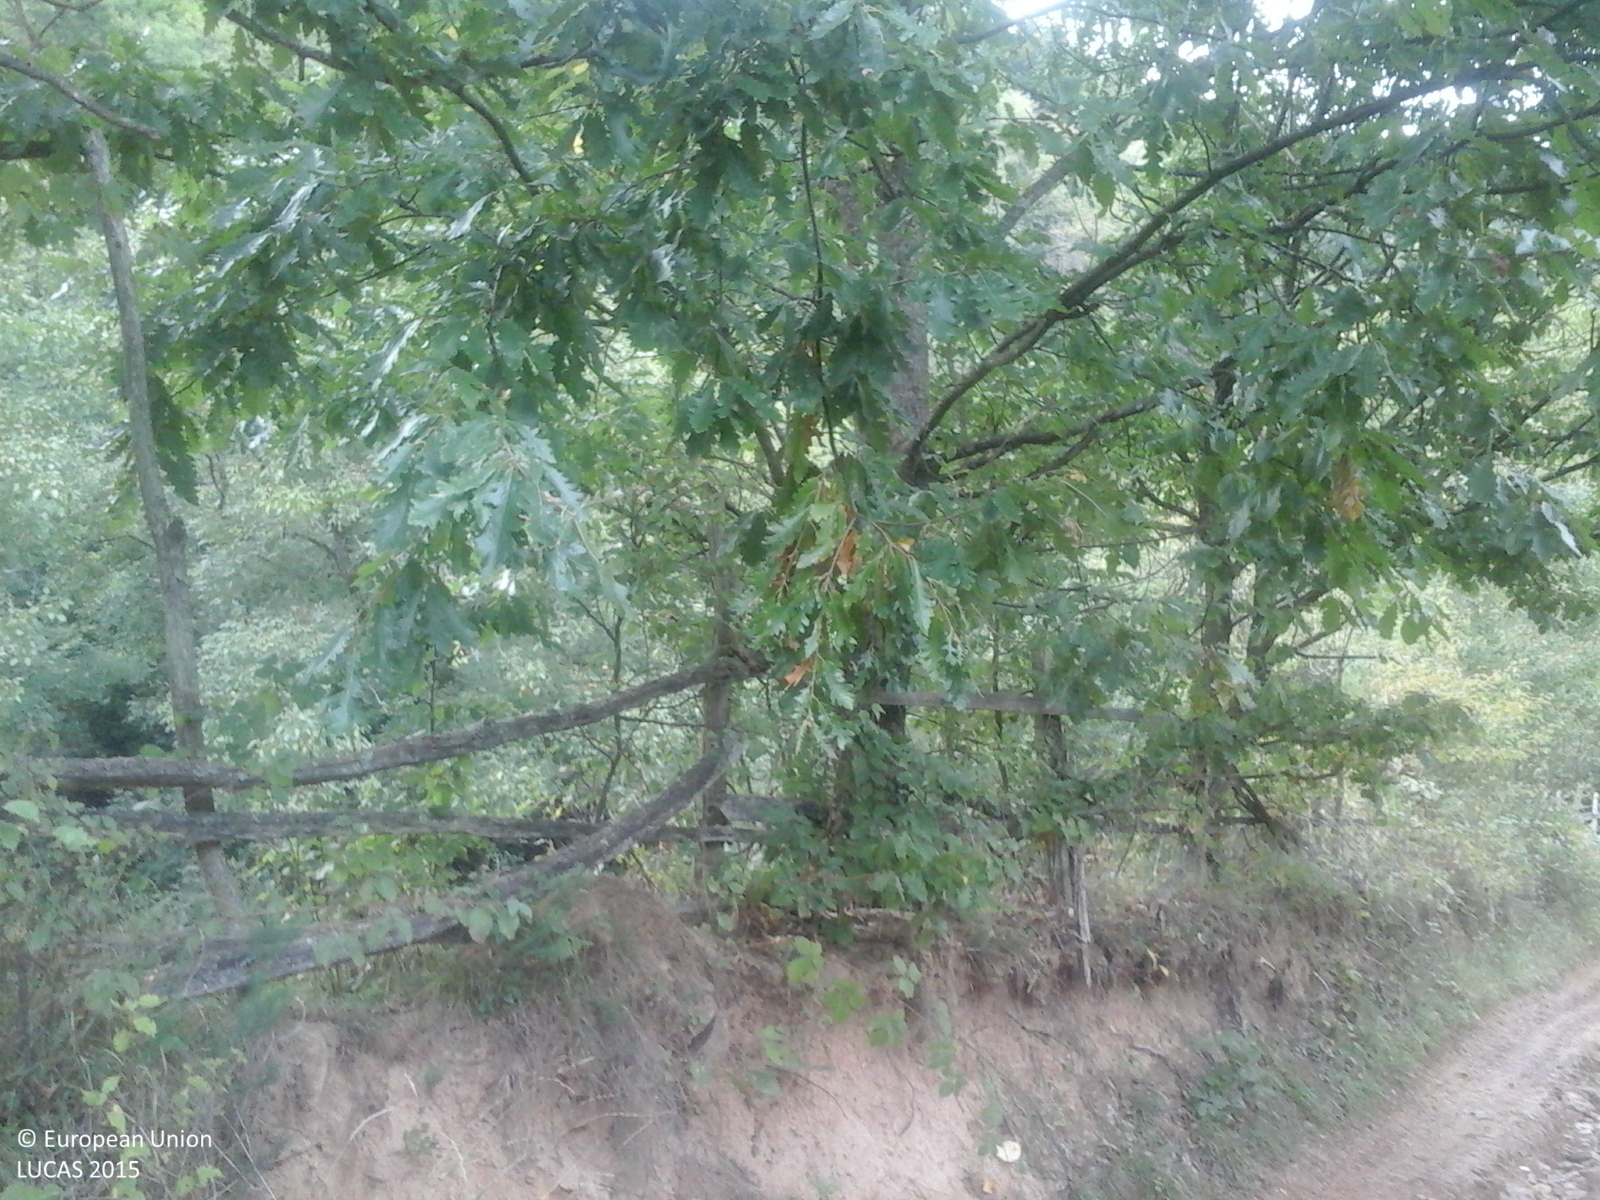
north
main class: Woodland
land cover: Broadleaved woodland
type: acidophilous oak and oak-birch forest
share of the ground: > 75 %
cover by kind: broadleaved forest trees 100 %
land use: Forestry
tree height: > 5 m
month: September
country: RO
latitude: 45.7925
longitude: 22.3825
